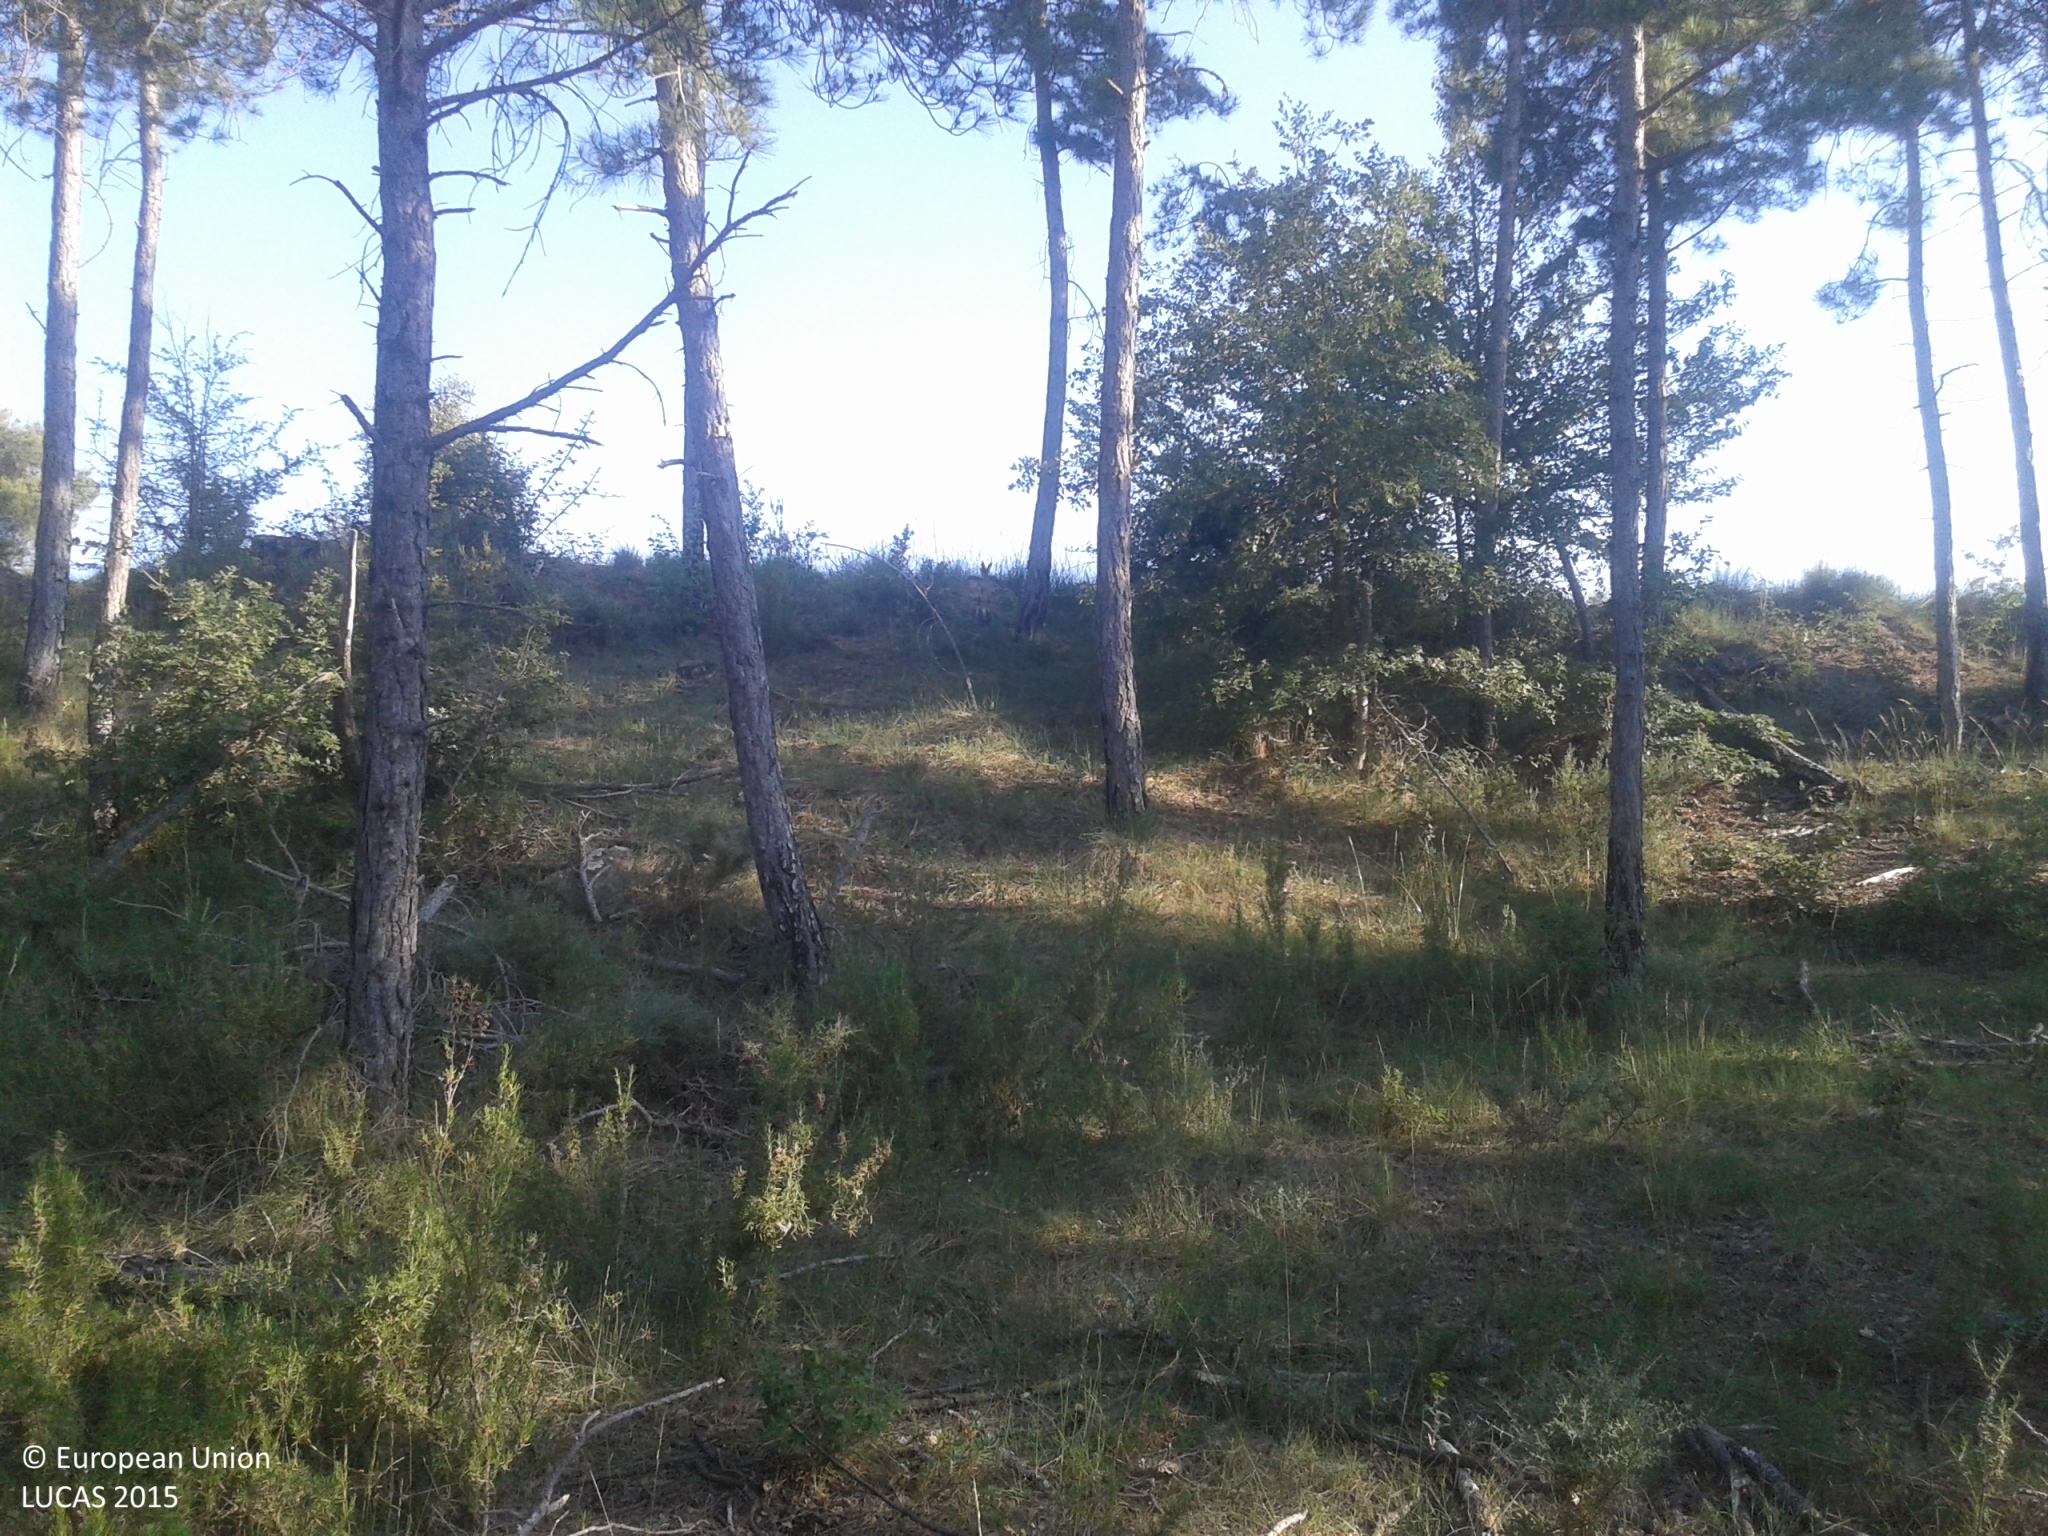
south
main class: Woodland
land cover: Pine dominated mixed woodland
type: coniferous forest of the mediterranean region
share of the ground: > 75 %
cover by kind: coniferous forest trees 60 %, broadleaved forest trees 20 %, shrubs 10 %, herbaceous plants 10 %
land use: Forestry
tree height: > 5 m
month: June
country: ES
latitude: 41.9620
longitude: 1.6275
